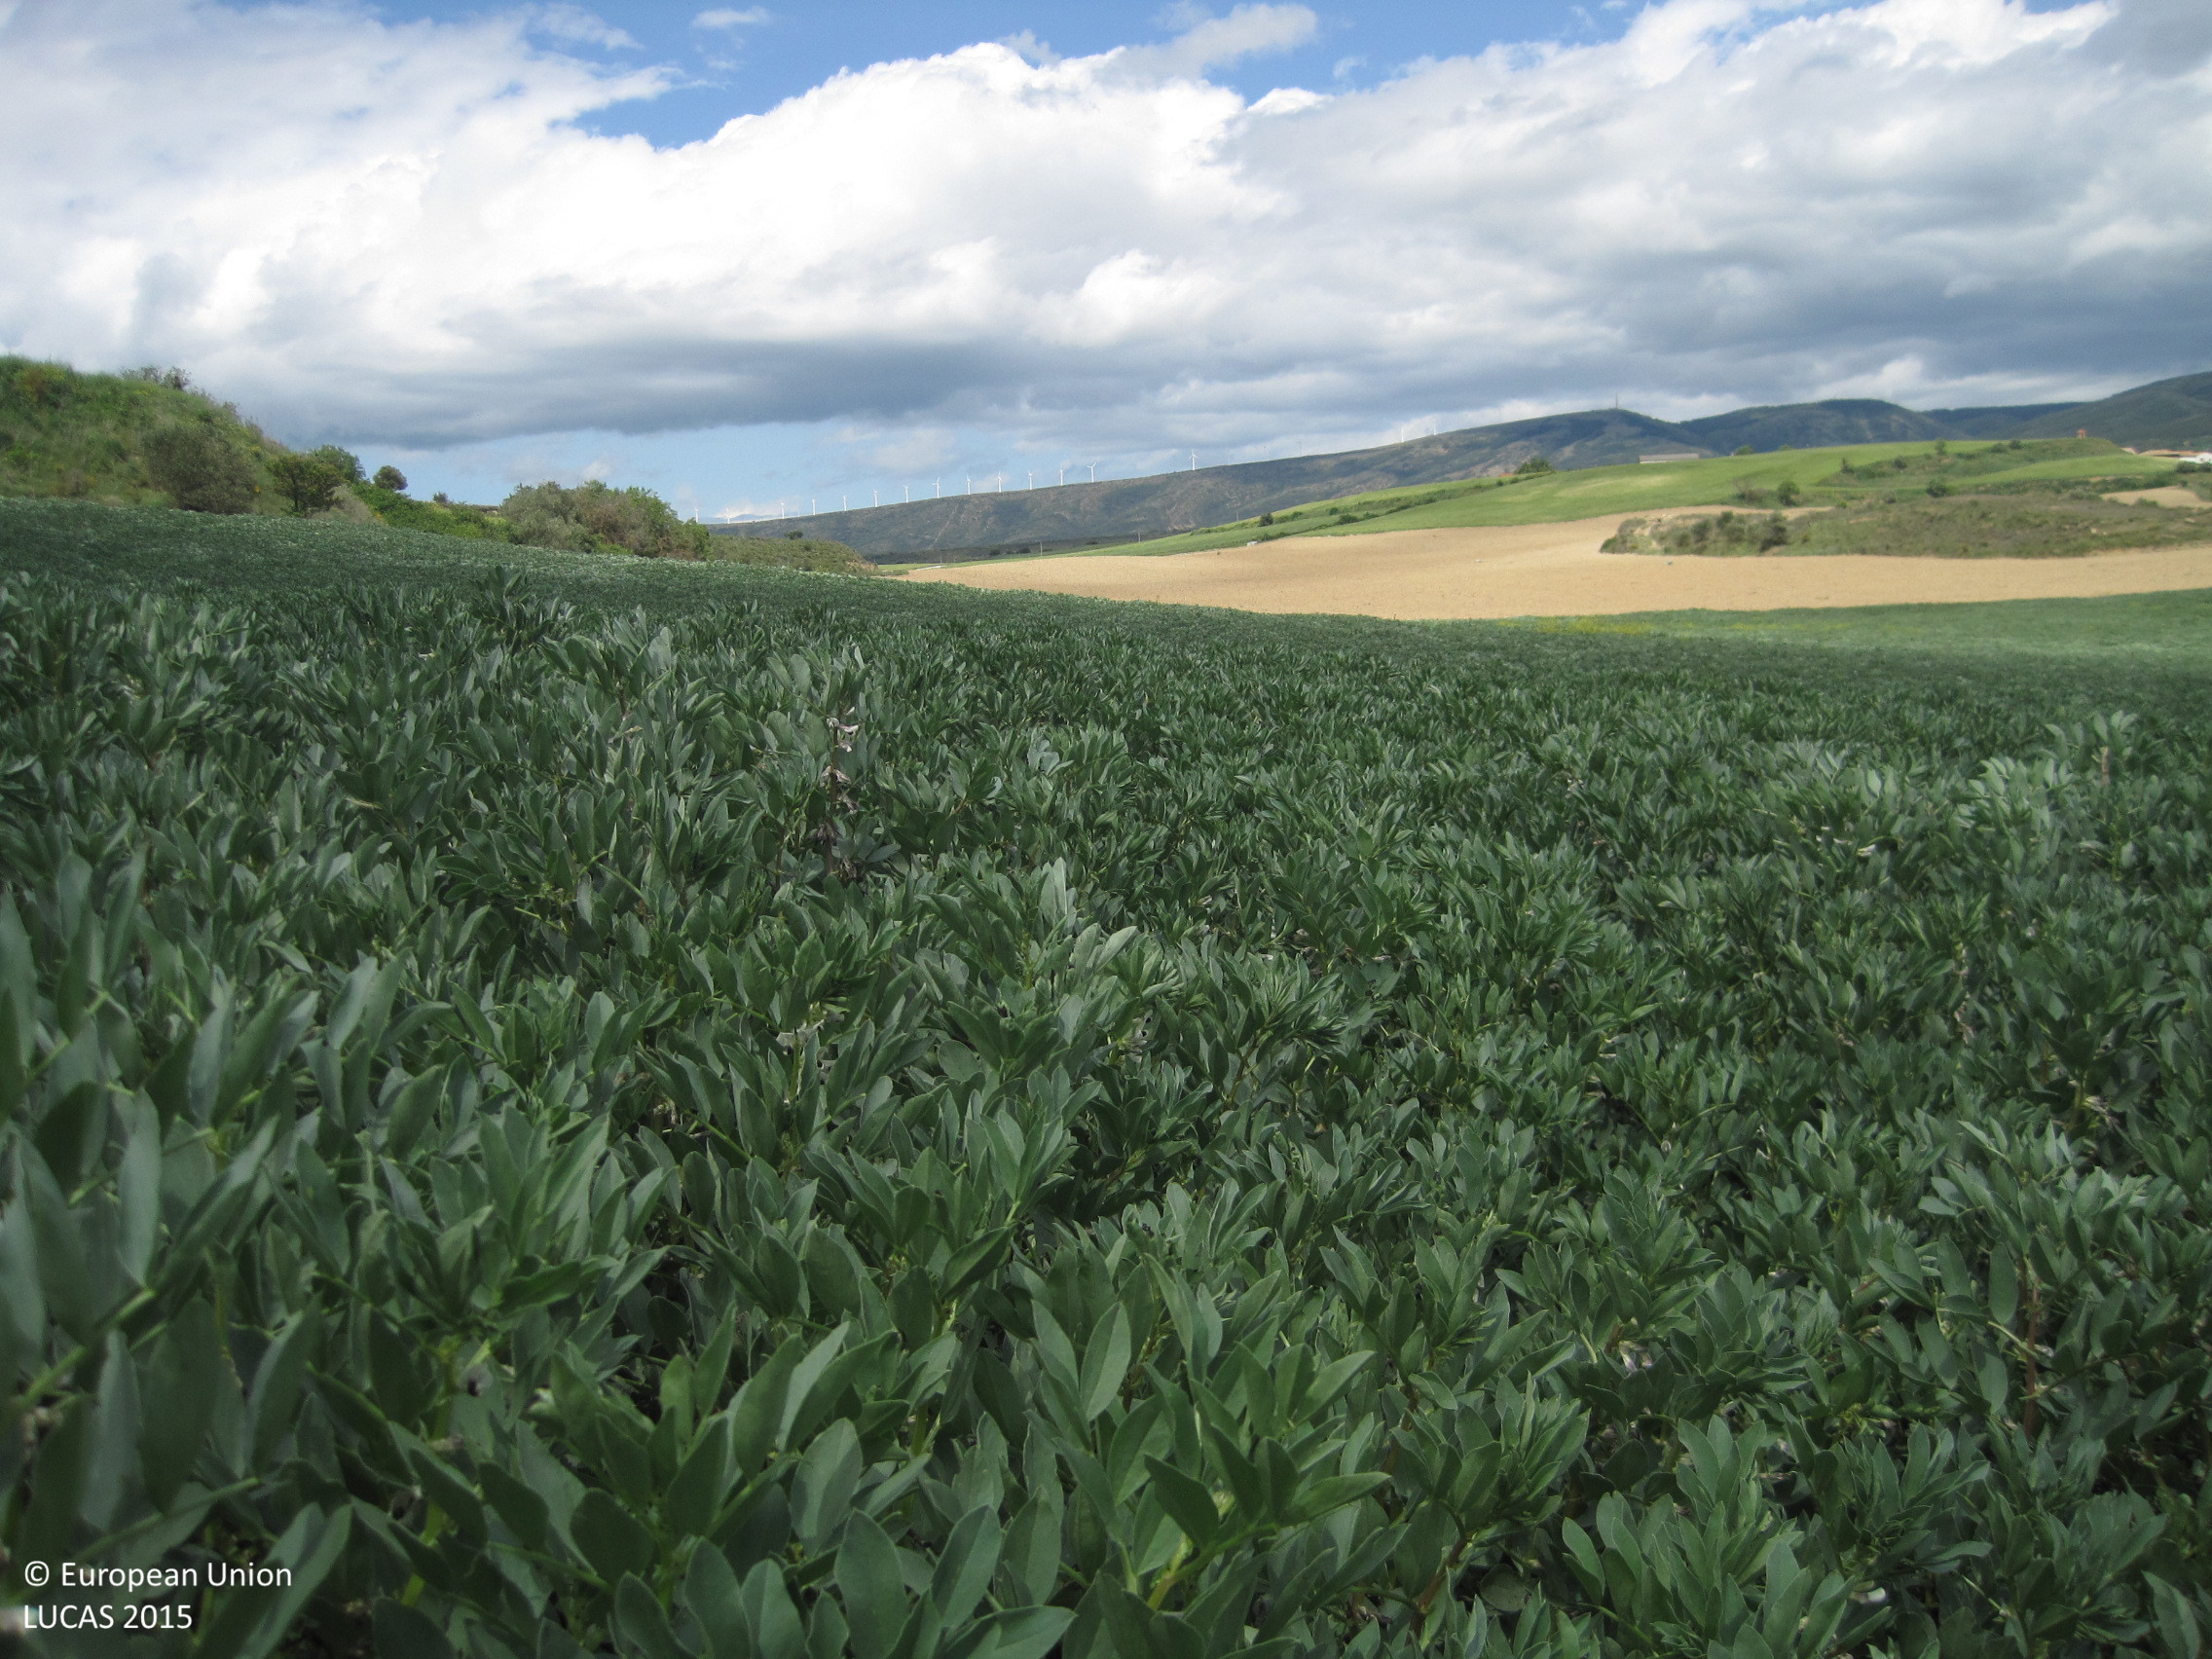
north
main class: Cropland
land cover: Dry pulses
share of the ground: > 75 %
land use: Agriculture (excluding fallow land and kitchen gardens)
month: May
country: ES
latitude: 42.6795
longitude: -1.7420
